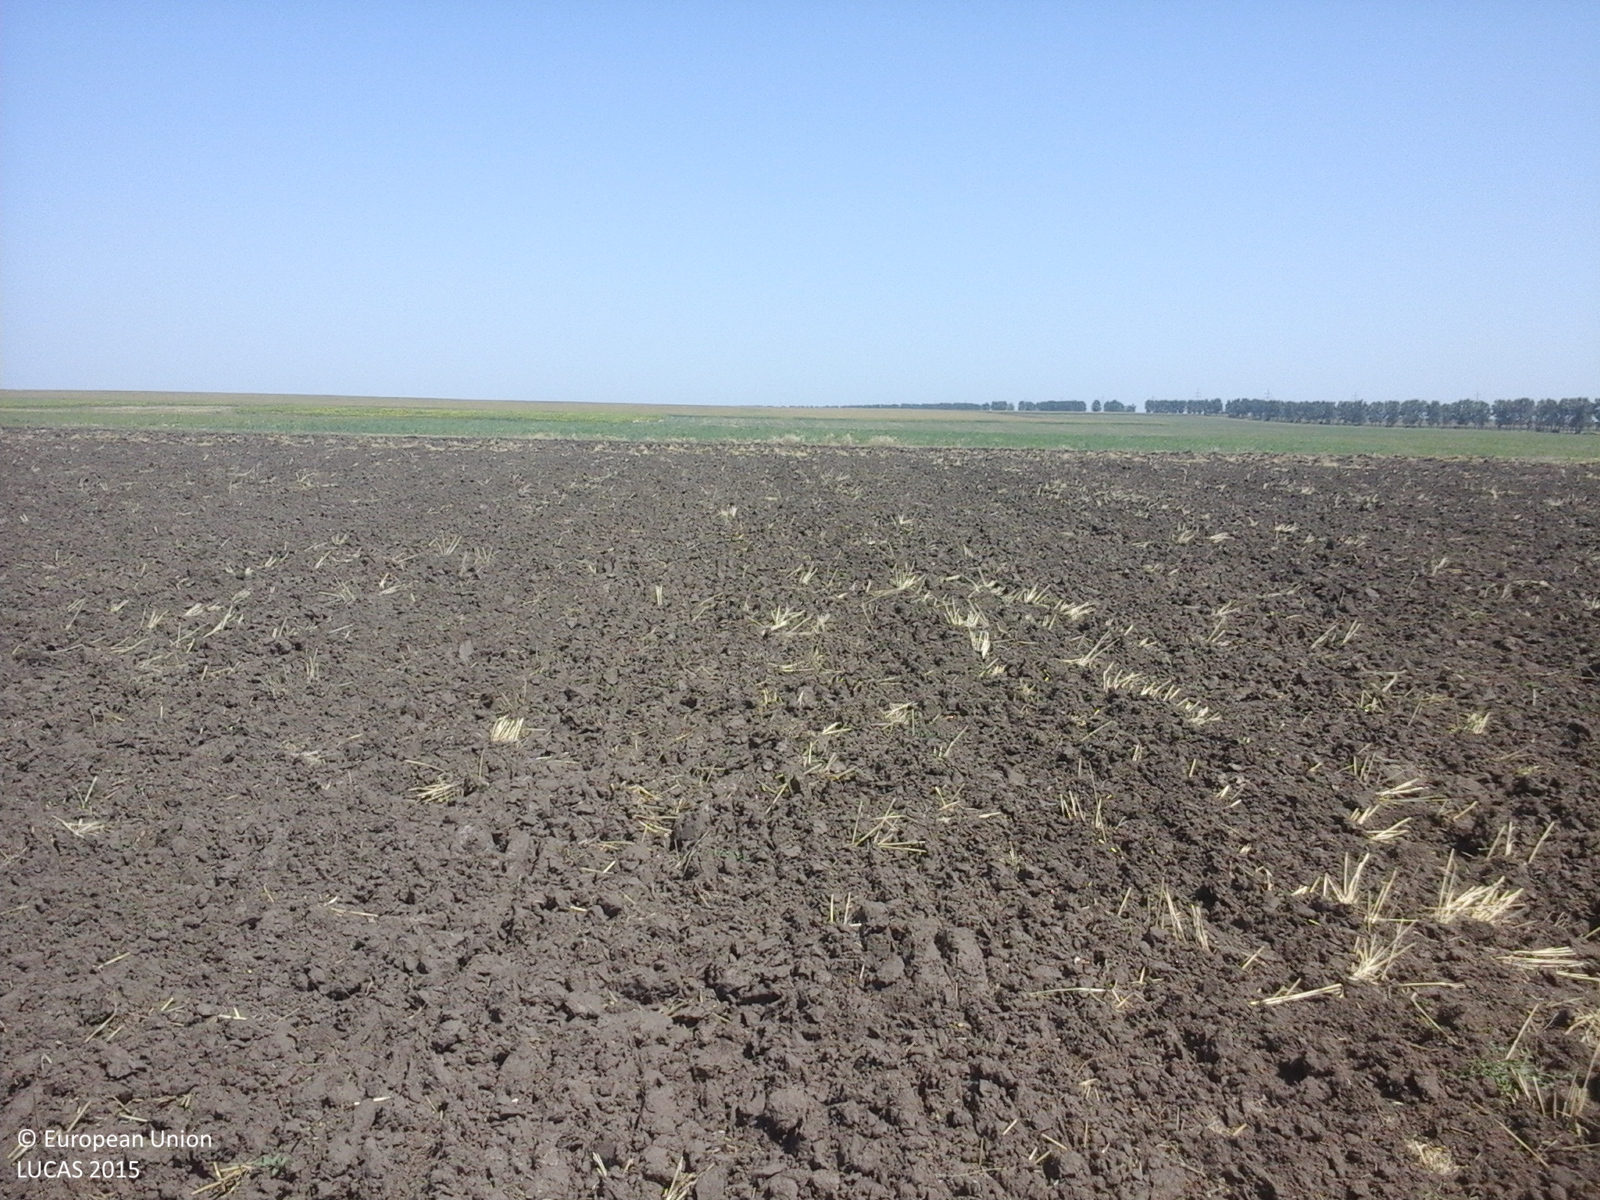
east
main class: Cropland
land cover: Common wheat
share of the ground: < 10 %
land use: Agriculture (excluding fallow land and kitchen gardens)
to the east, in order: Common wheat; Grass margins; Tracks; Spontaneously vegetated surfaces
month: July
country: RO
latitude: 44.2467
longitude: 26.6341
